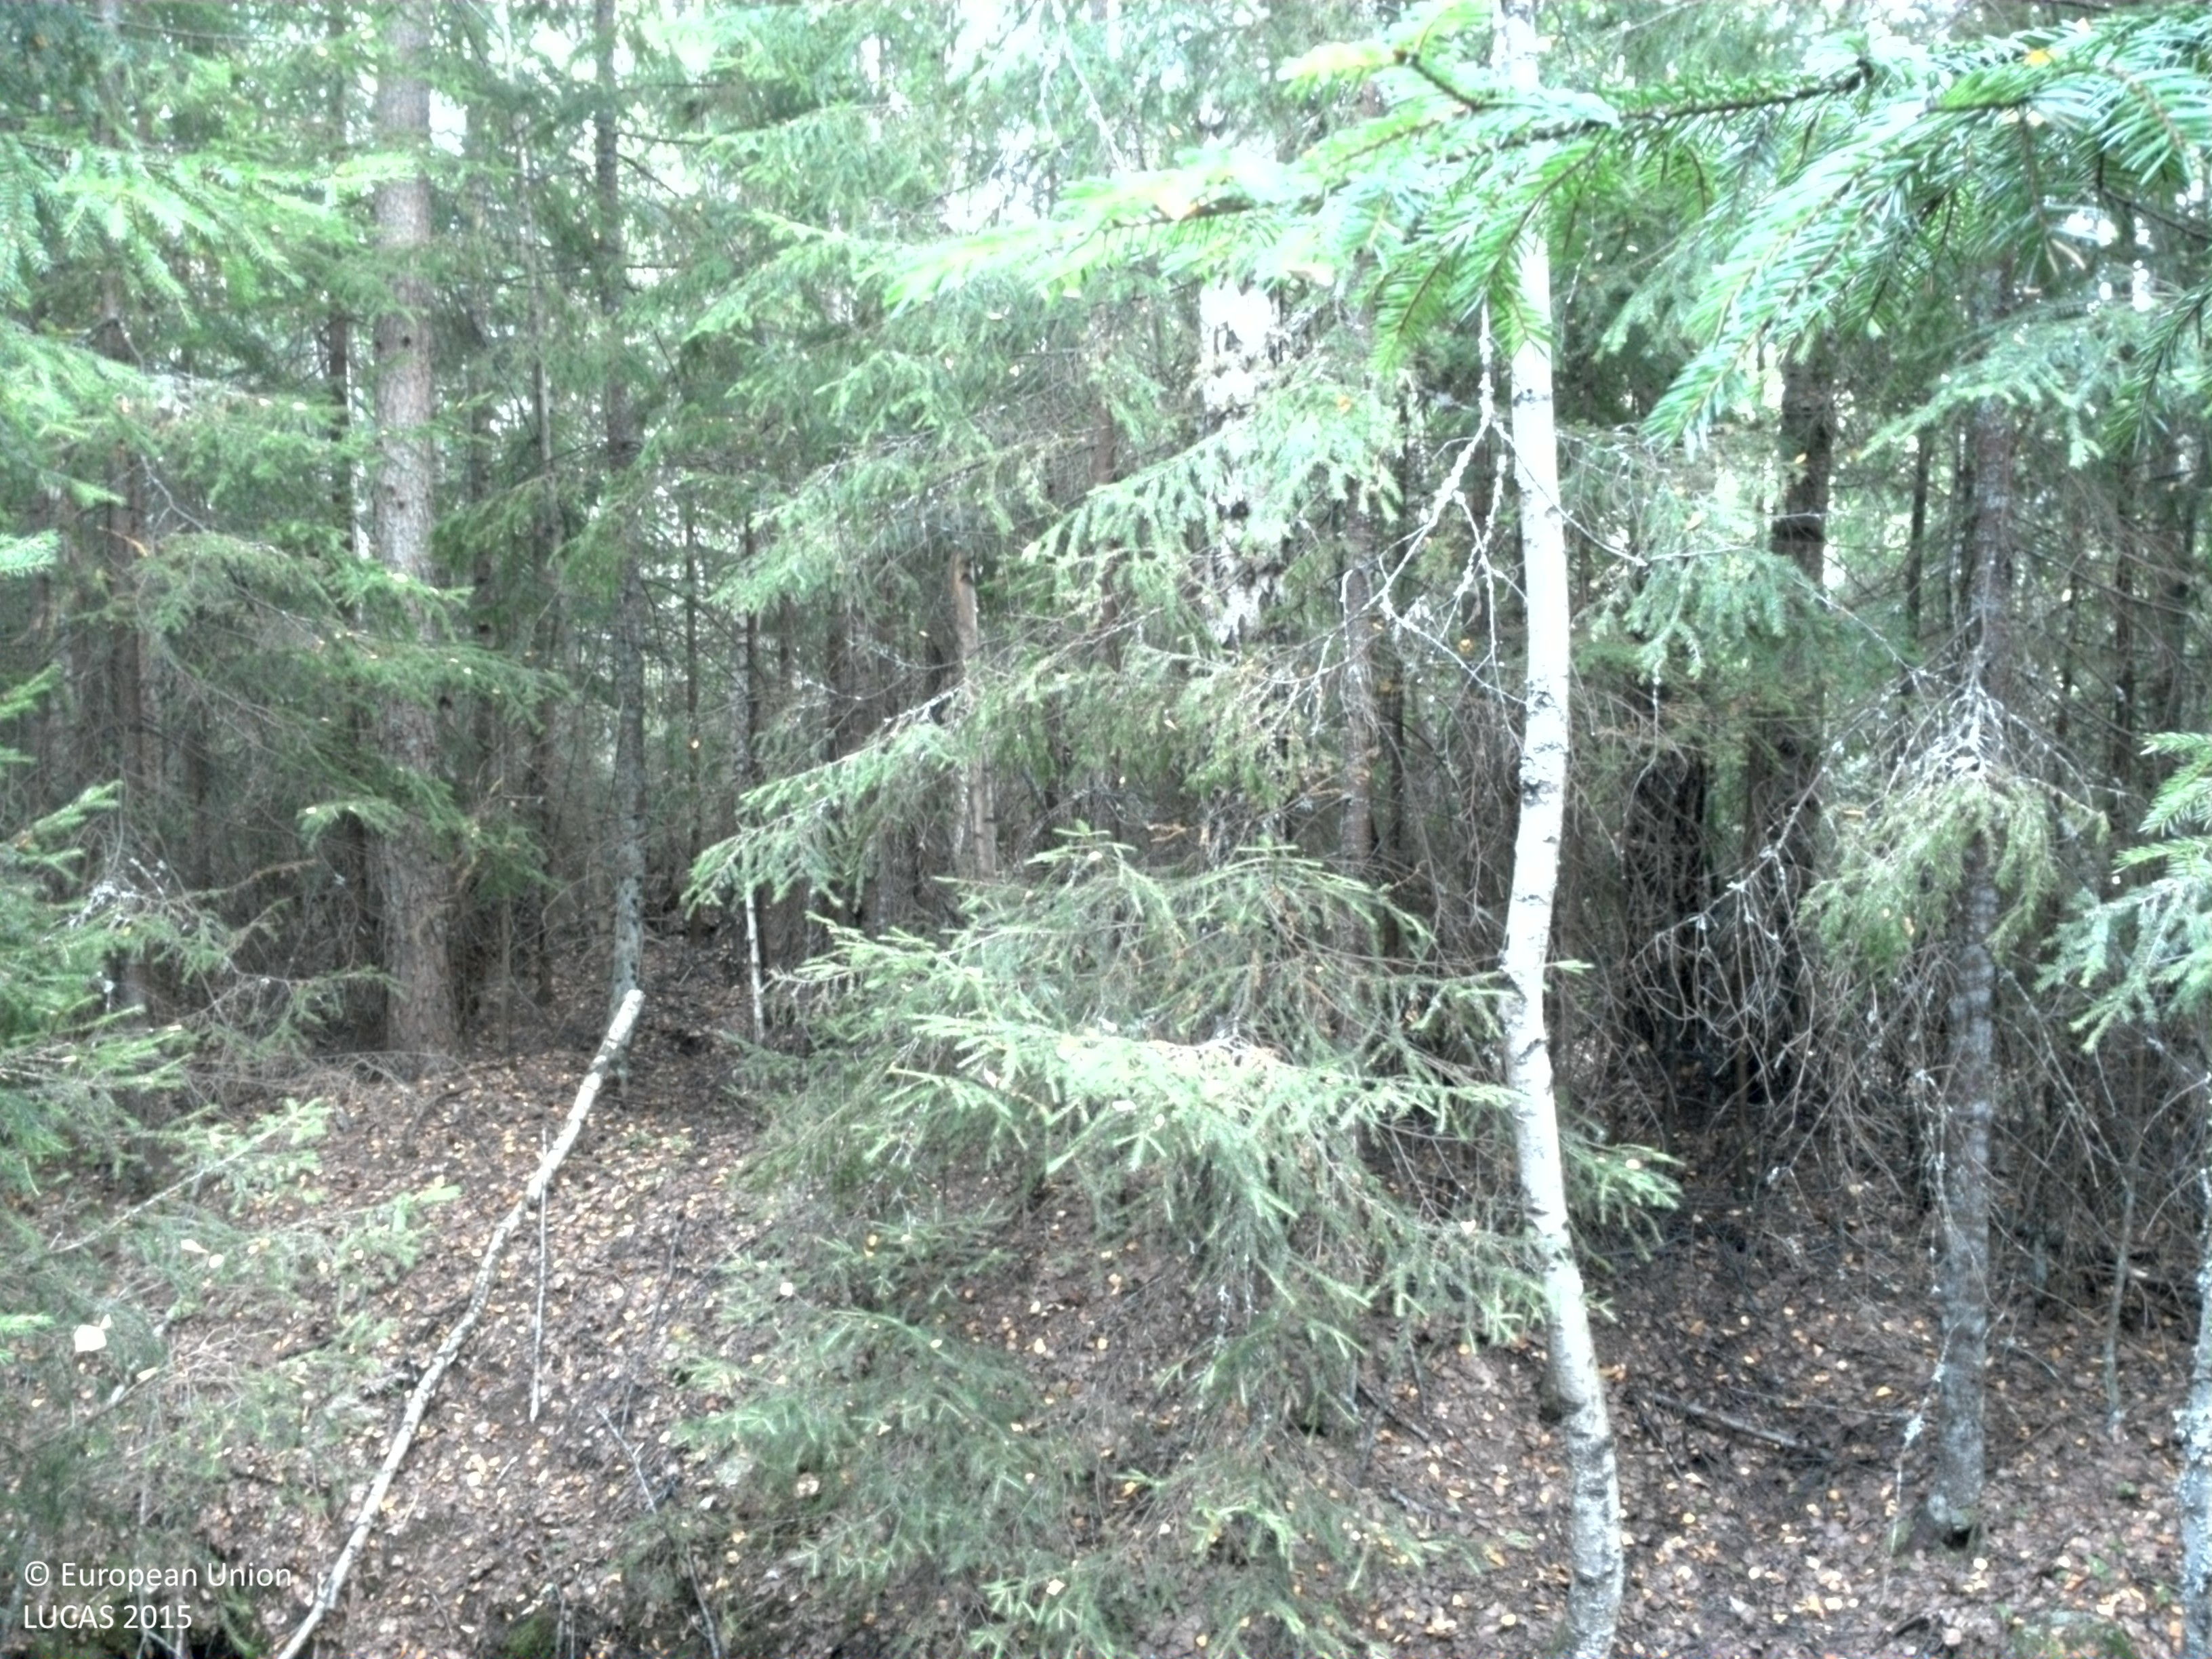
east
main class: Woodland
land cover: Spruce dominated mixed woodland
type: boreal forest
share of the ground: > 75 %
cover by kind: coniferous forest trees 55 %, broadleaved forest trees 25 %, lichens and mosses 5 %
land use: Forestry
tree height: > 5 m
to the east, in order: Spruce dominated mixed woodland; Ditches and canals; Spruce dominated mixed woodland; Pine dominated mixed woodland; Pine dominated coniferous woodland; Peatbogs
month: August
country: SE
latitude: 59.8660
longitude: 15.7225
